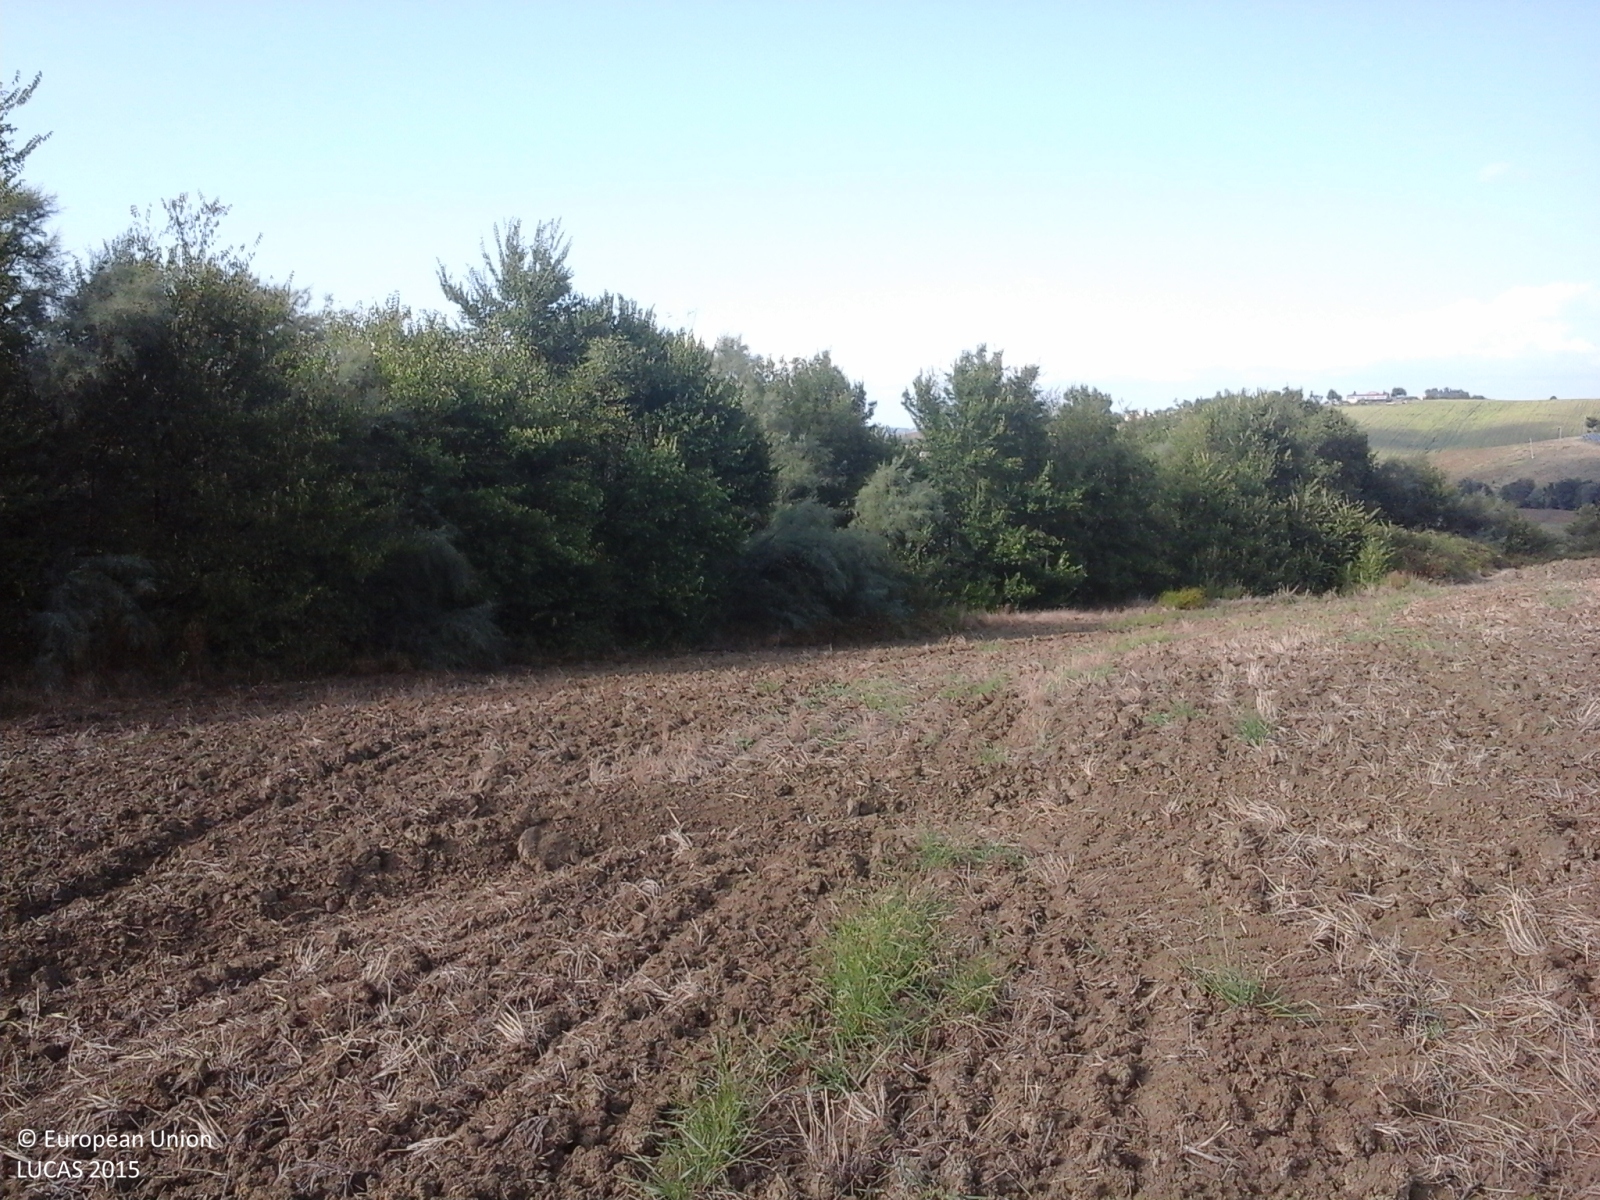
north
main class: Cropland
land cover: Dry pulses
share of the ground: < 10 %
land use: Agriculture (excluding fallow land and kitchen gardens)
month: August
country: IT
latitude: 43.4694
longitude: 13.2429
